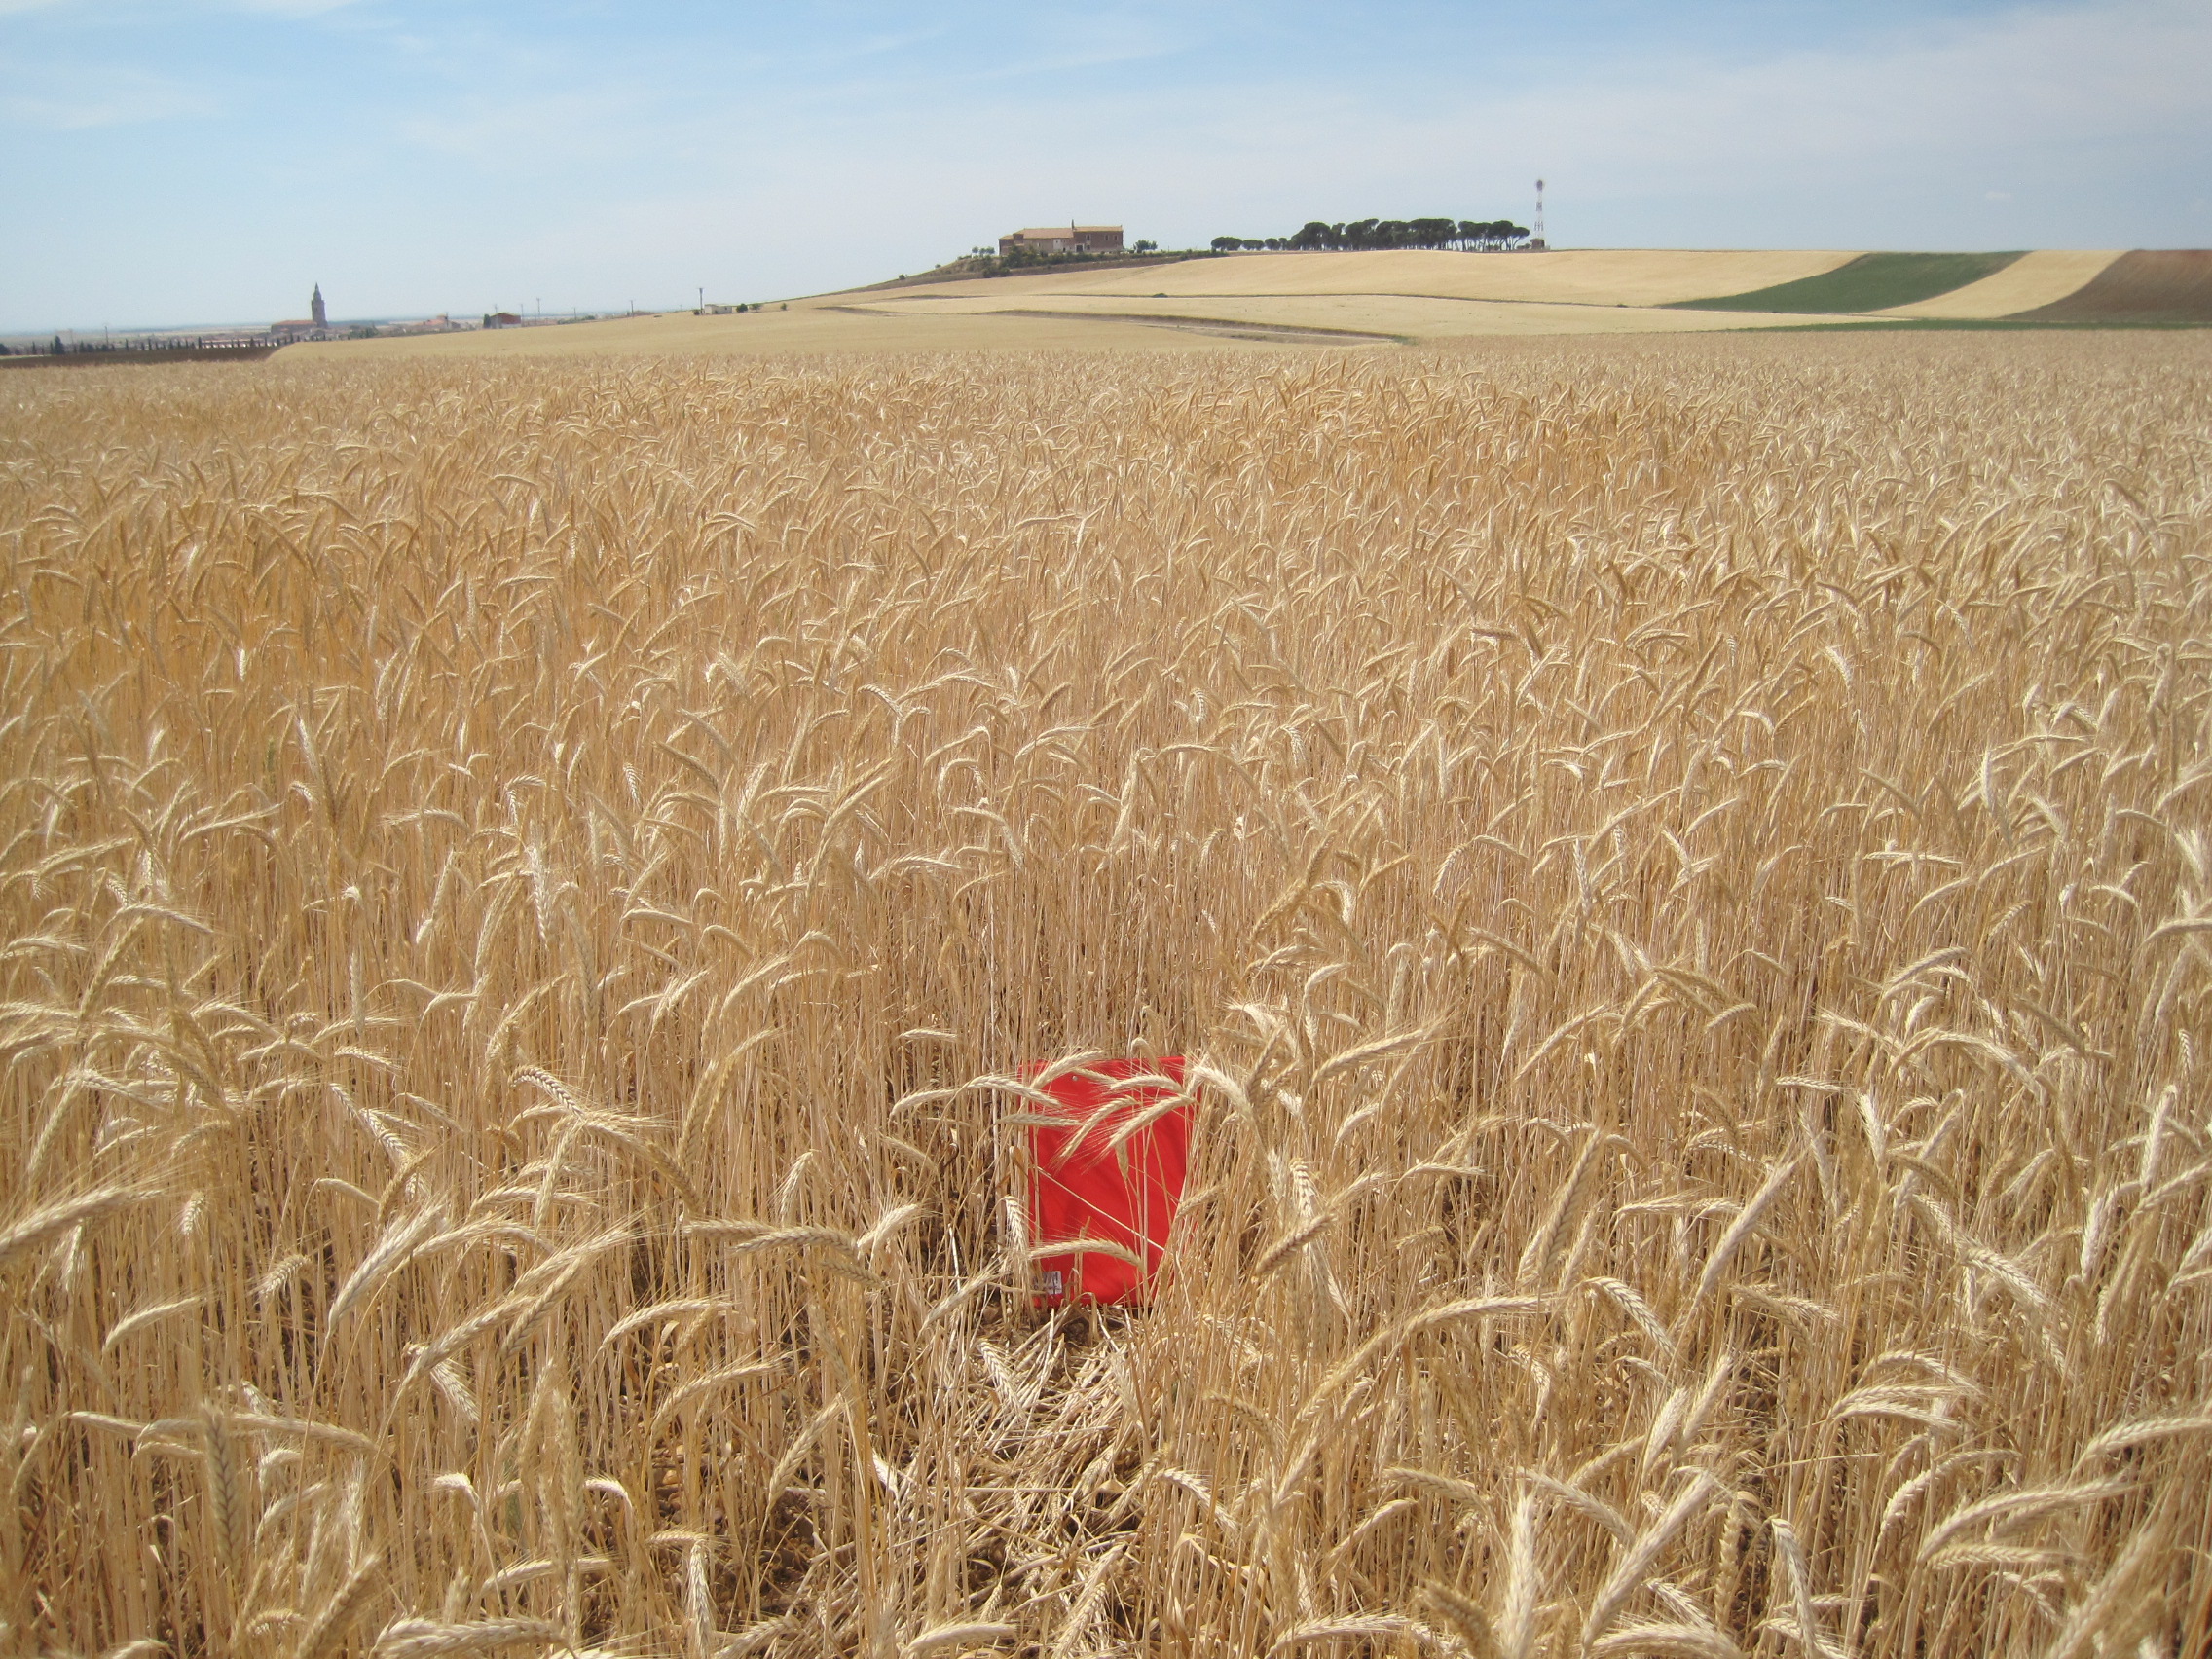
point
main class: Cropland
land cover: Triticale
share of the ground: > 75 %
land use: Agriculture (excluding fallow land and kitchen gardens)
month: June
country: ES
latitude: 41.3501
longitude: -5.0954
